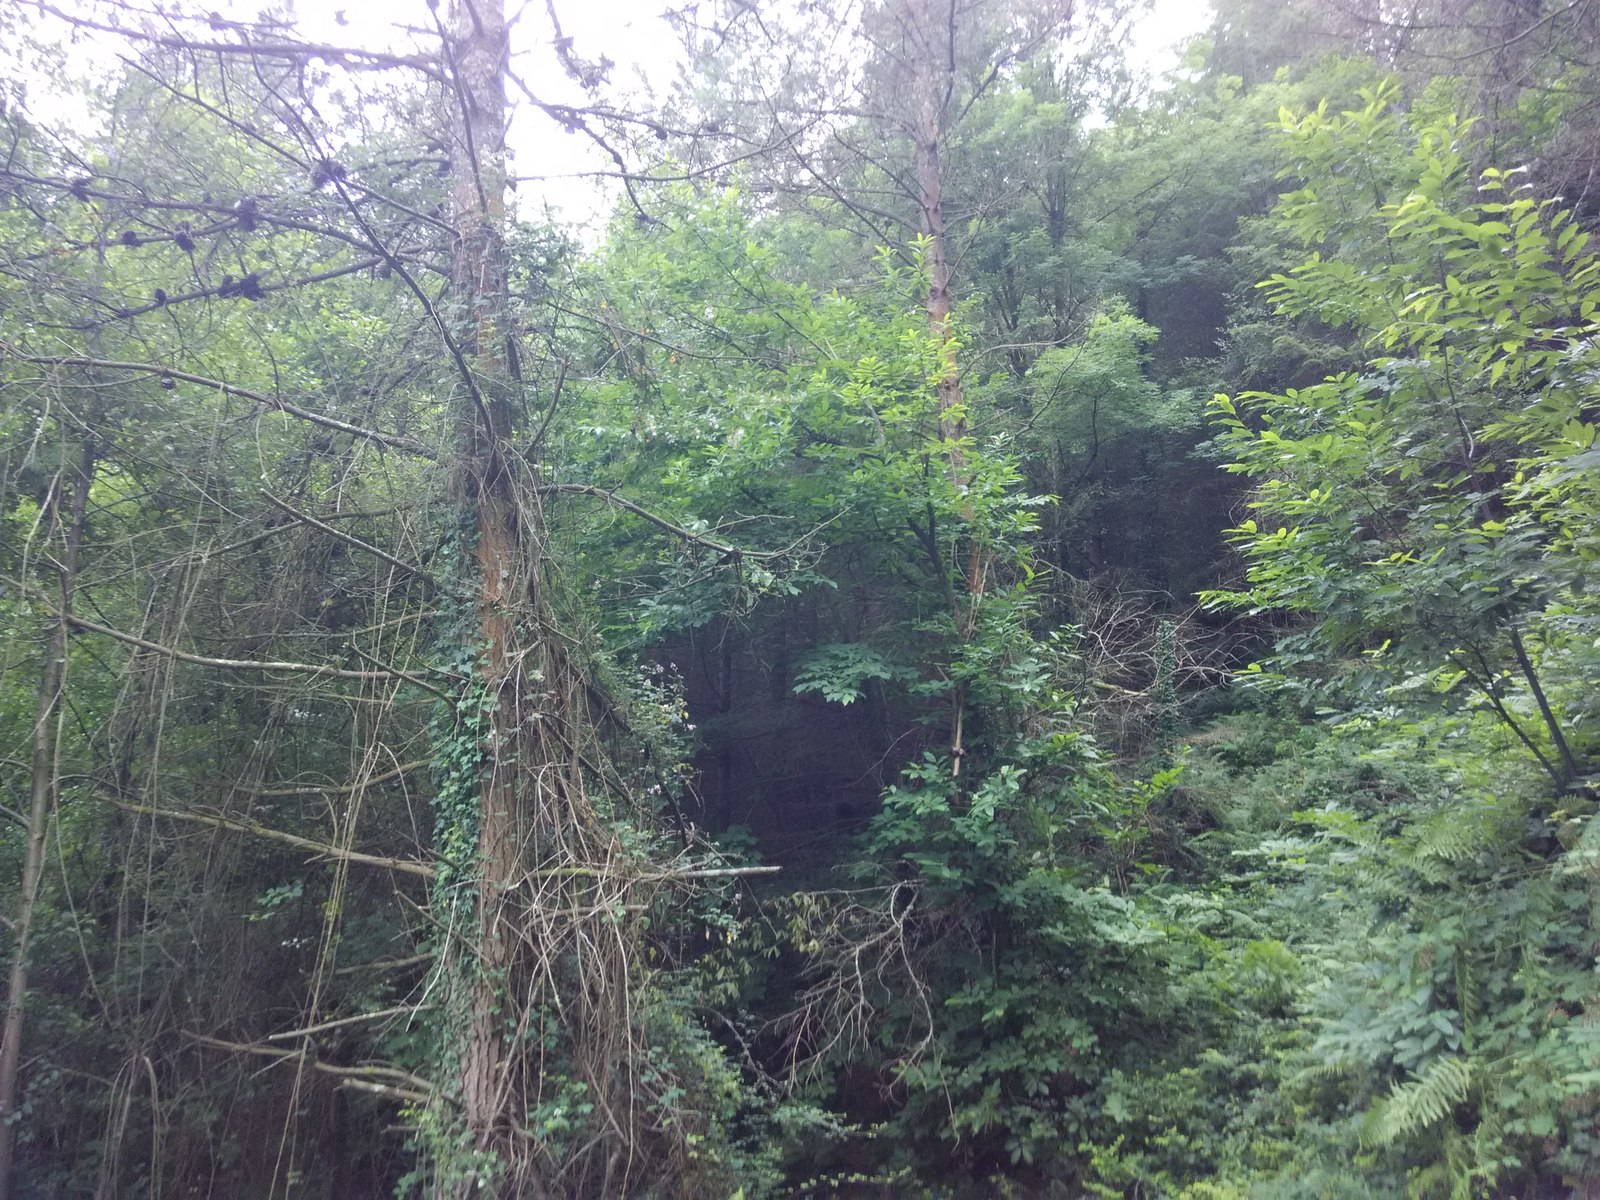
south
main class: Woodland
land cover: Pine dominated coniferous woodland
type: exotic forest
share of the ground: > 75 %
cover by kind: coniferous forest trees 100 %
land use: Forestry
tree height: > 5 m
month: July
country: ES
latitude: 43.1793
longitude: -2.4401
